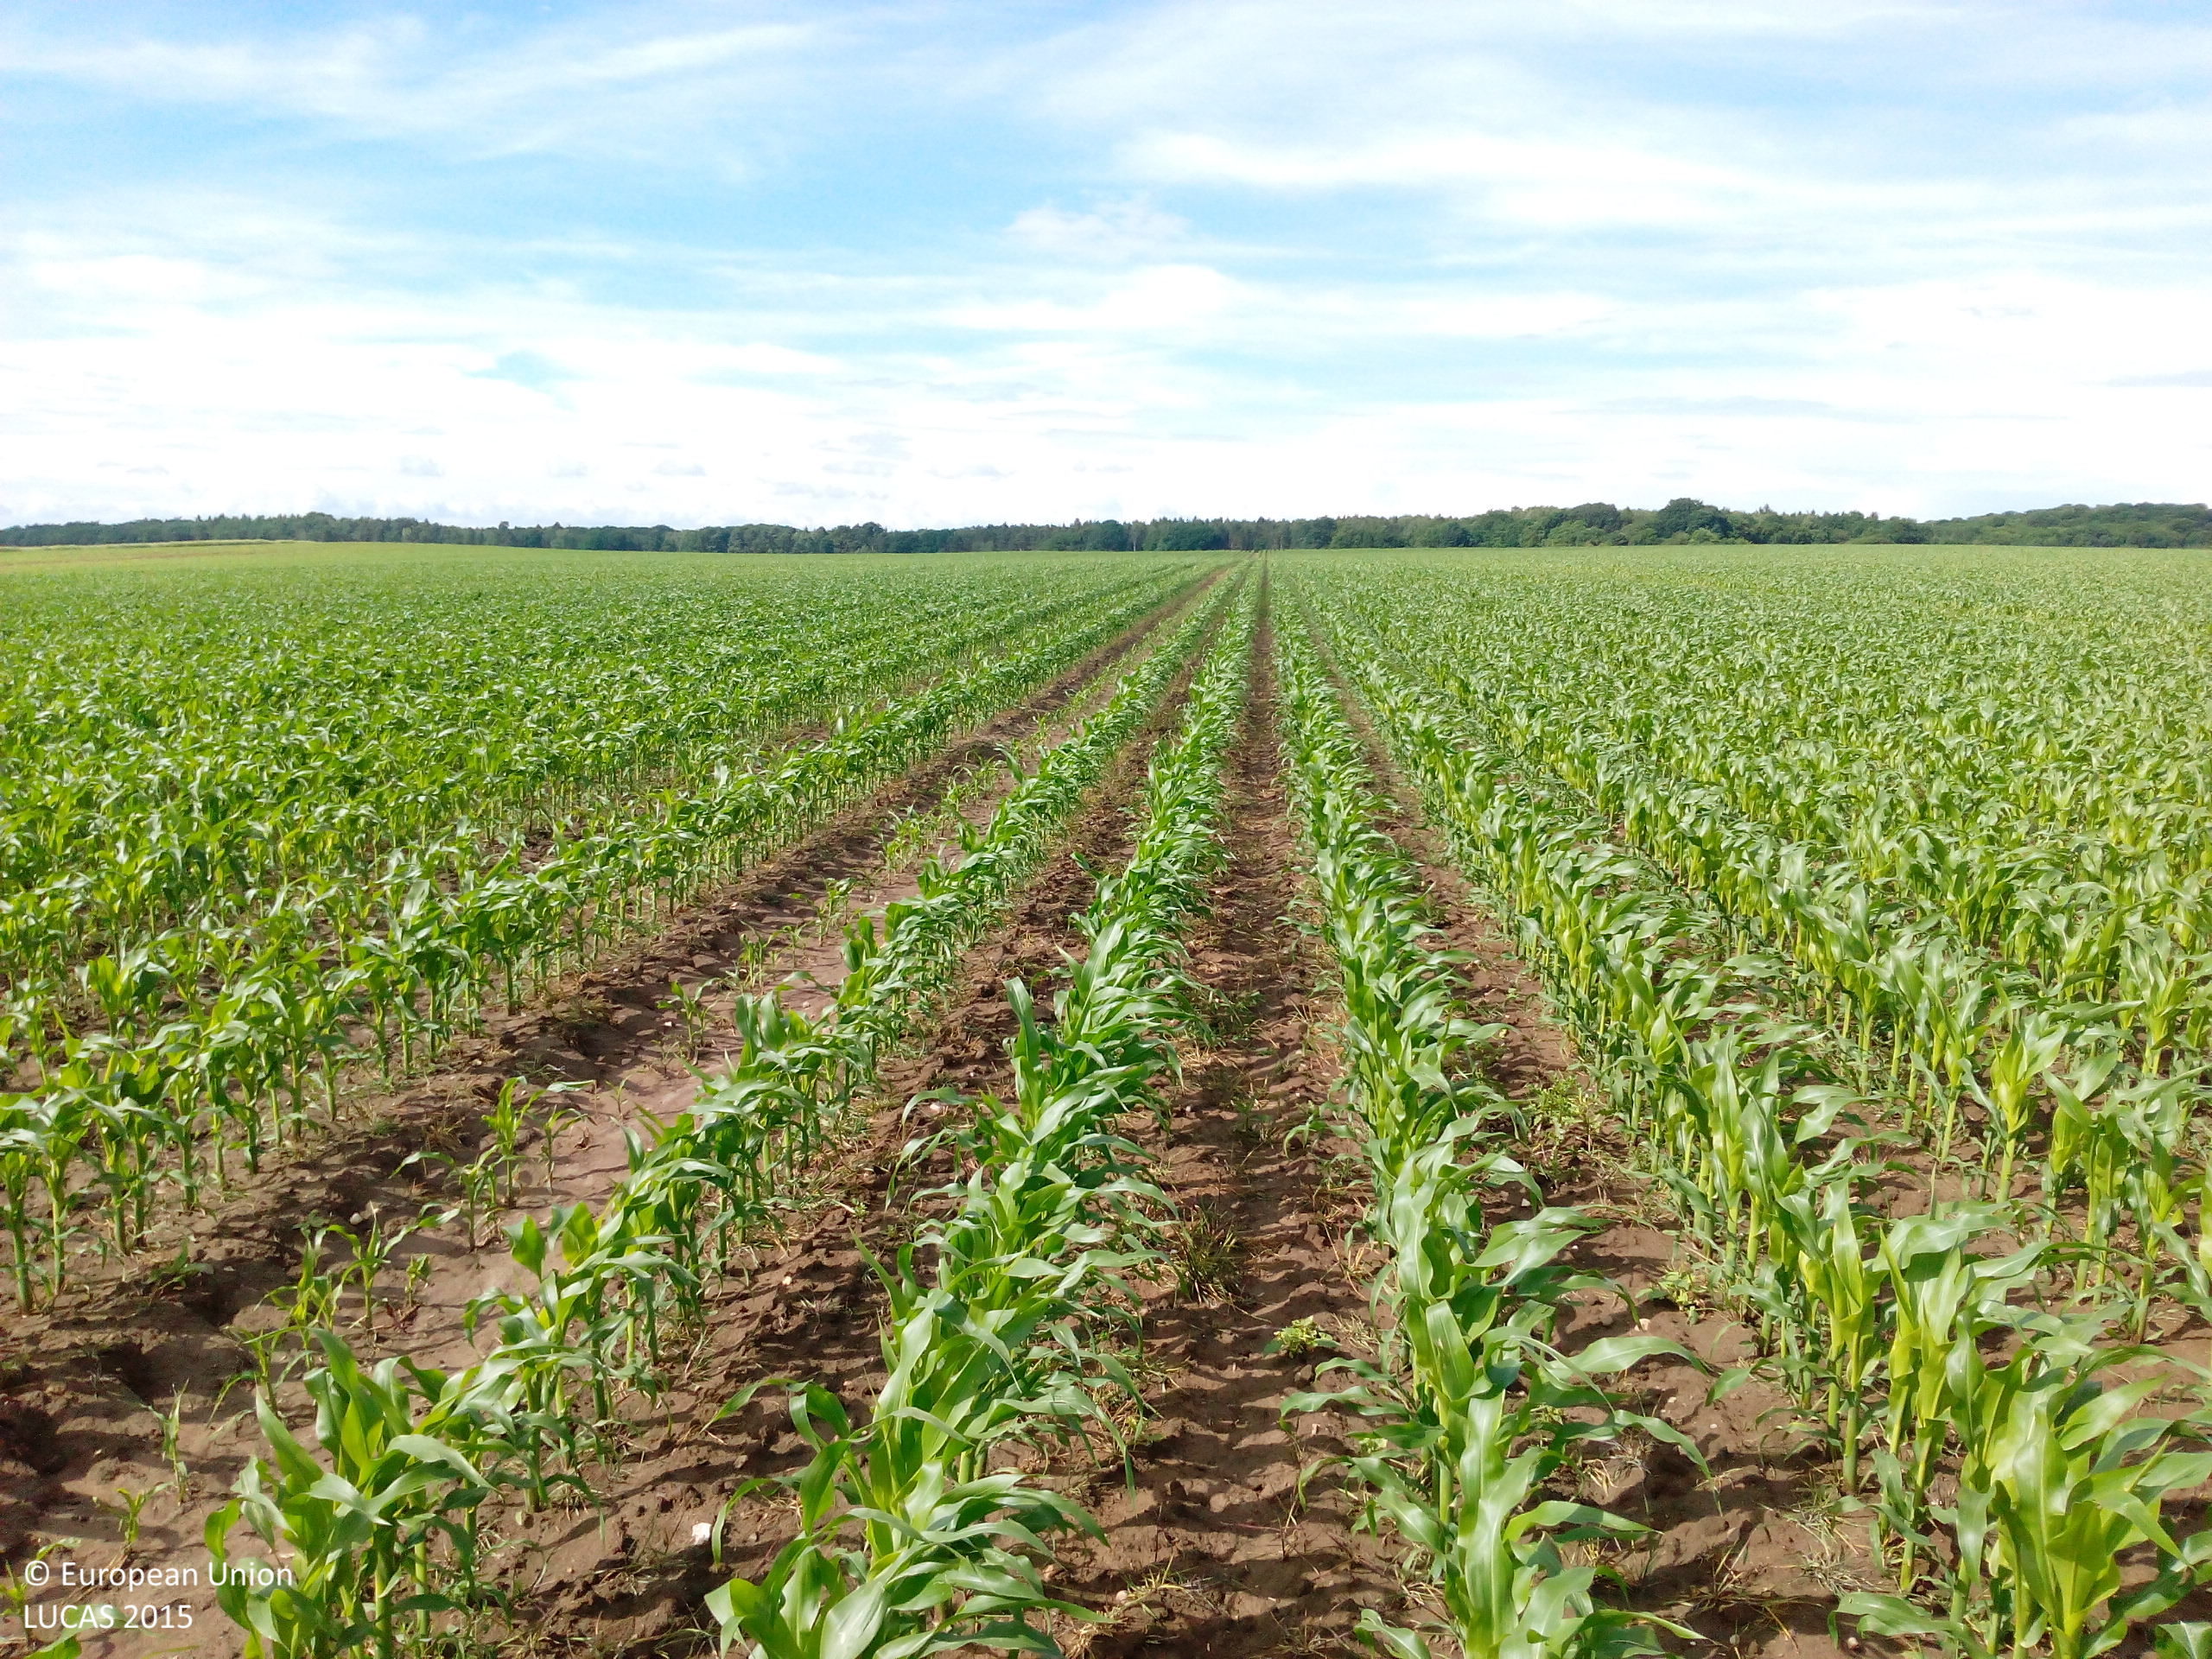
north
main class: Cropland
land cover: Maize
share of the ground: 10 - 25 %
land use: Agriculture (excluding fallow land and kitchen gardens)
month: June
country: DE
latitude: 52.2463
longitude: 11.1274
